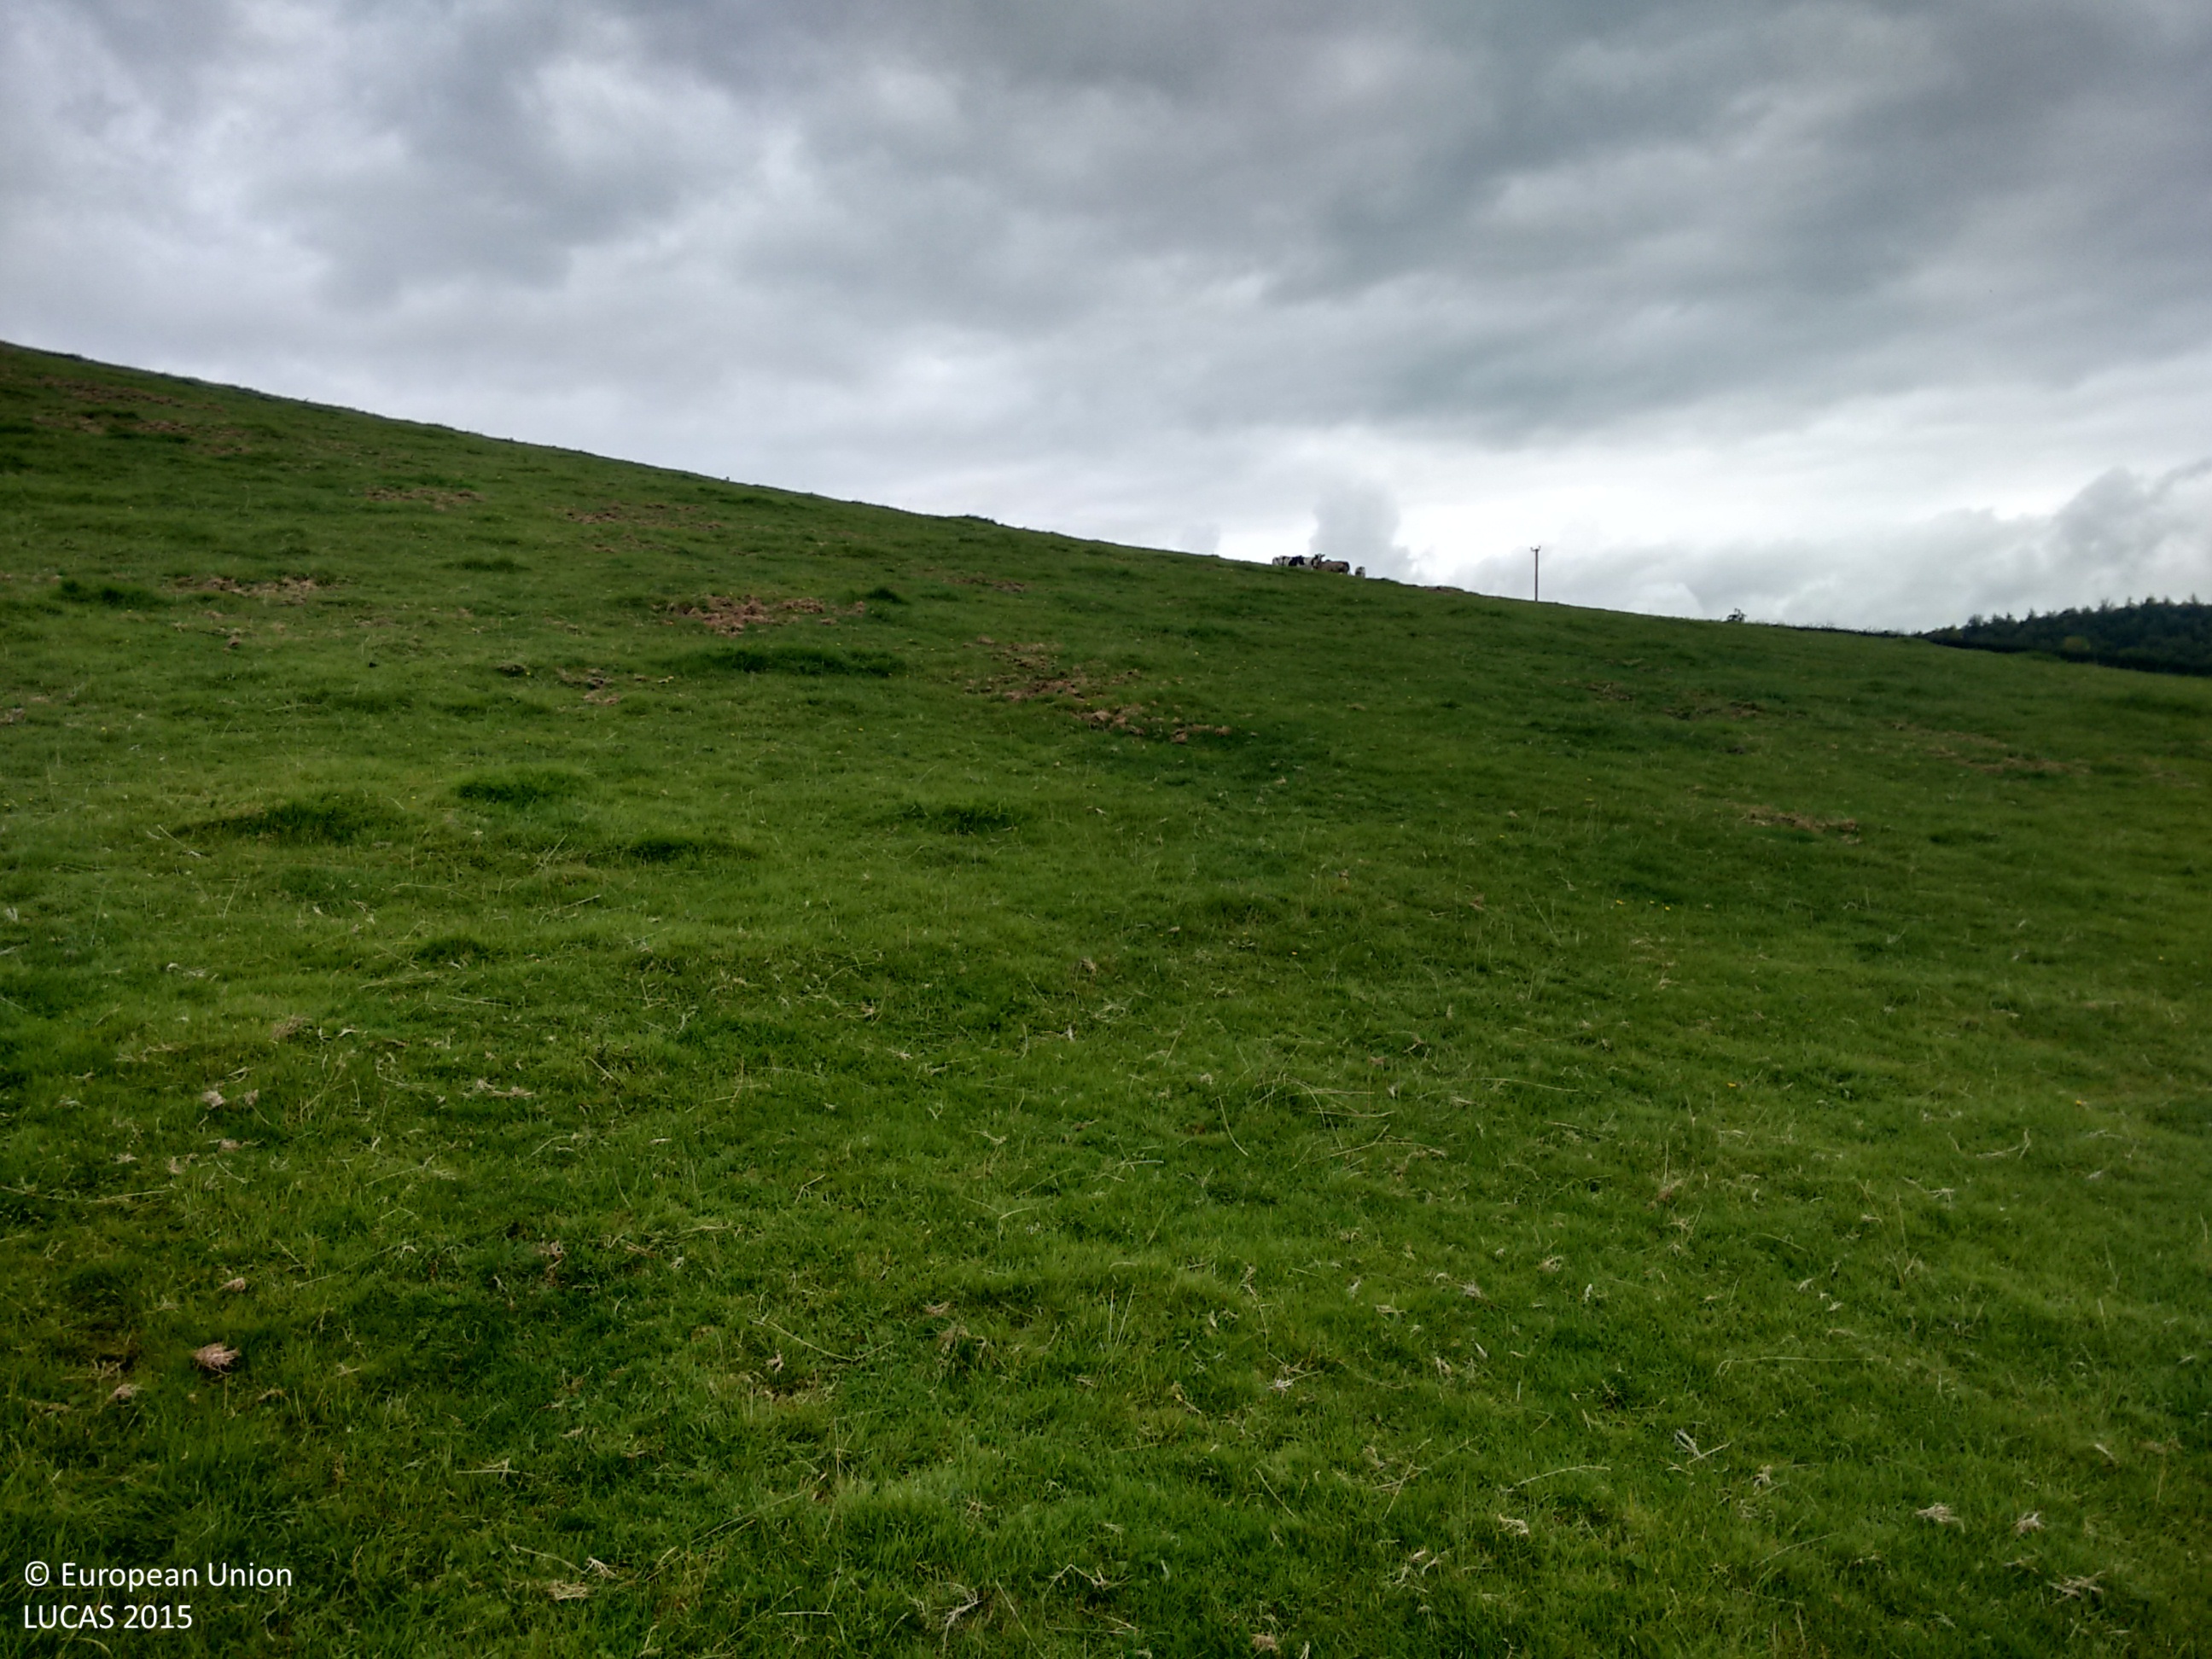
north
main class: Grassland
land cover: Grassland without tree/shrub cover
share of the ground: > 75 %
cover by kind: herbaceous plants 100 %
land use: Agriculture (excluding fallow land and kitchen gardens)
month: September
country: GB
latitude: 52.7538
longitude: -3.3116
